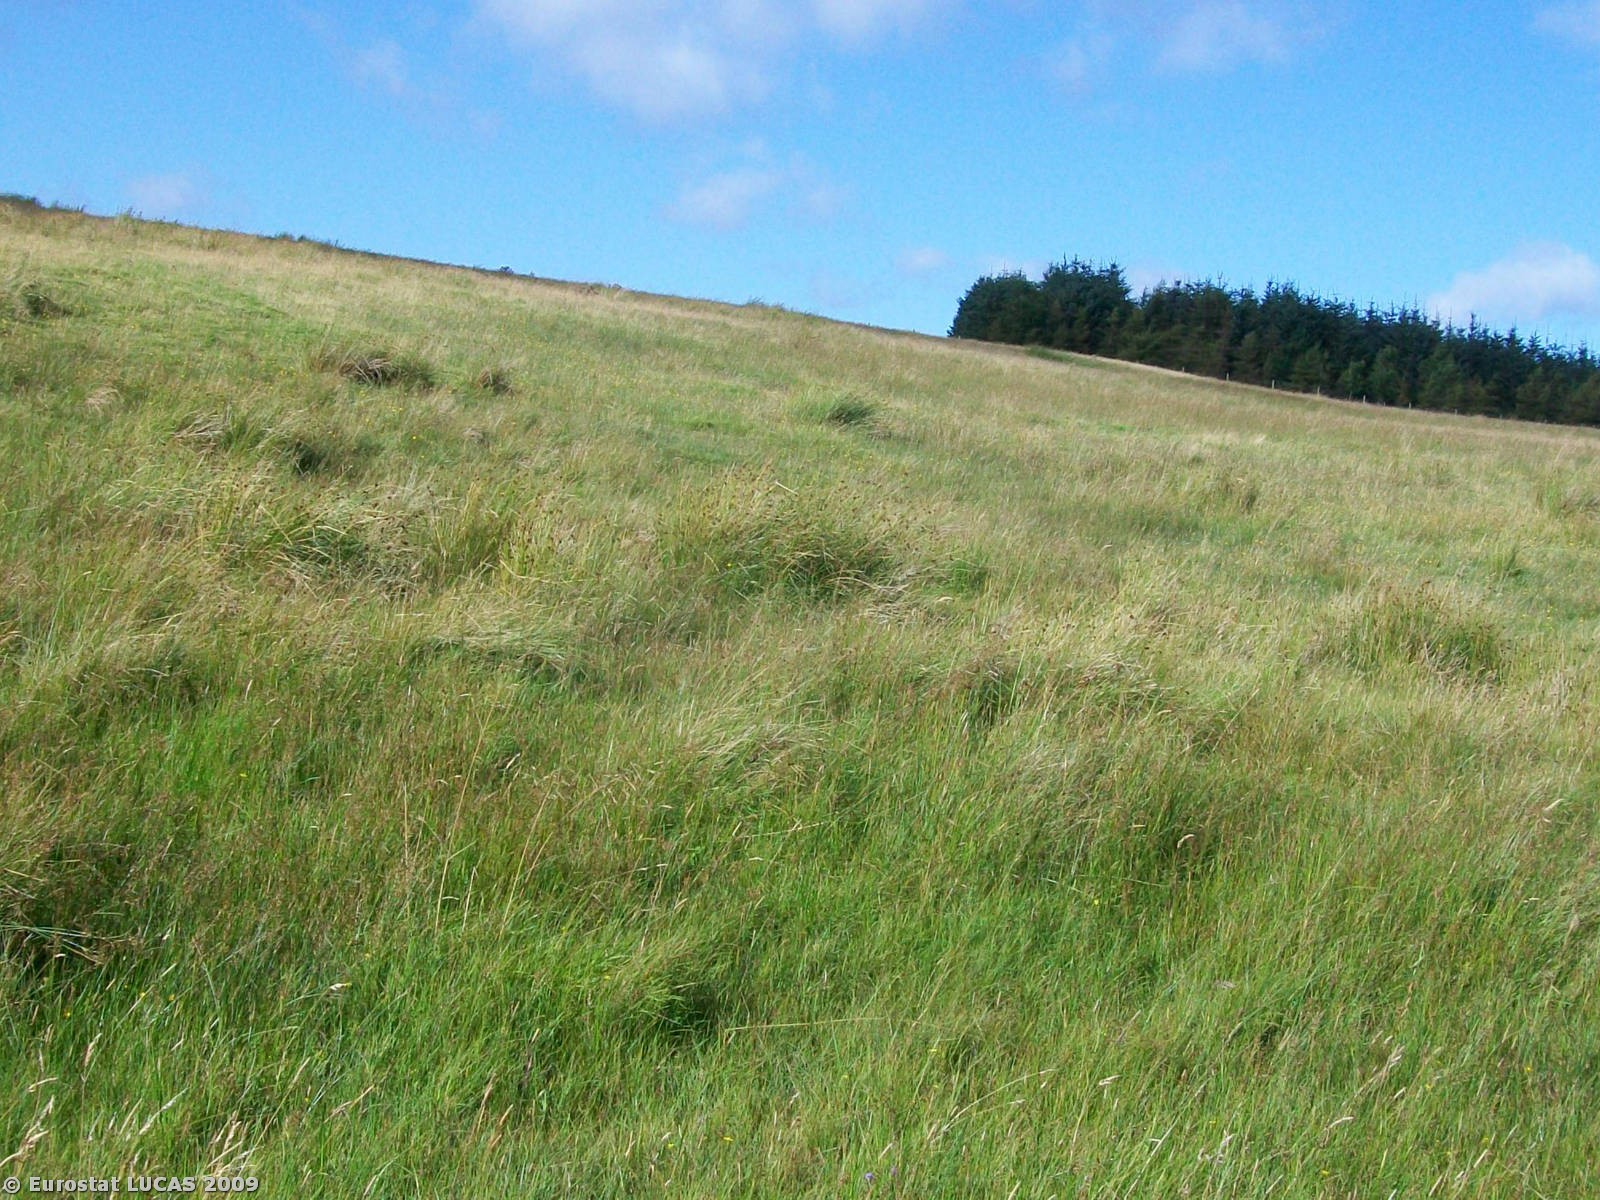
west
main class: Grassland
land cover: Grassland without tree/shrub cover
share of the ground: < 10 %
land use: Agriculture (excluding fallow land and kitchen gardens)
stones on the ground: < 10 %
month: August
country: GB
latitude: 55.1313
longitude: -4.8688
